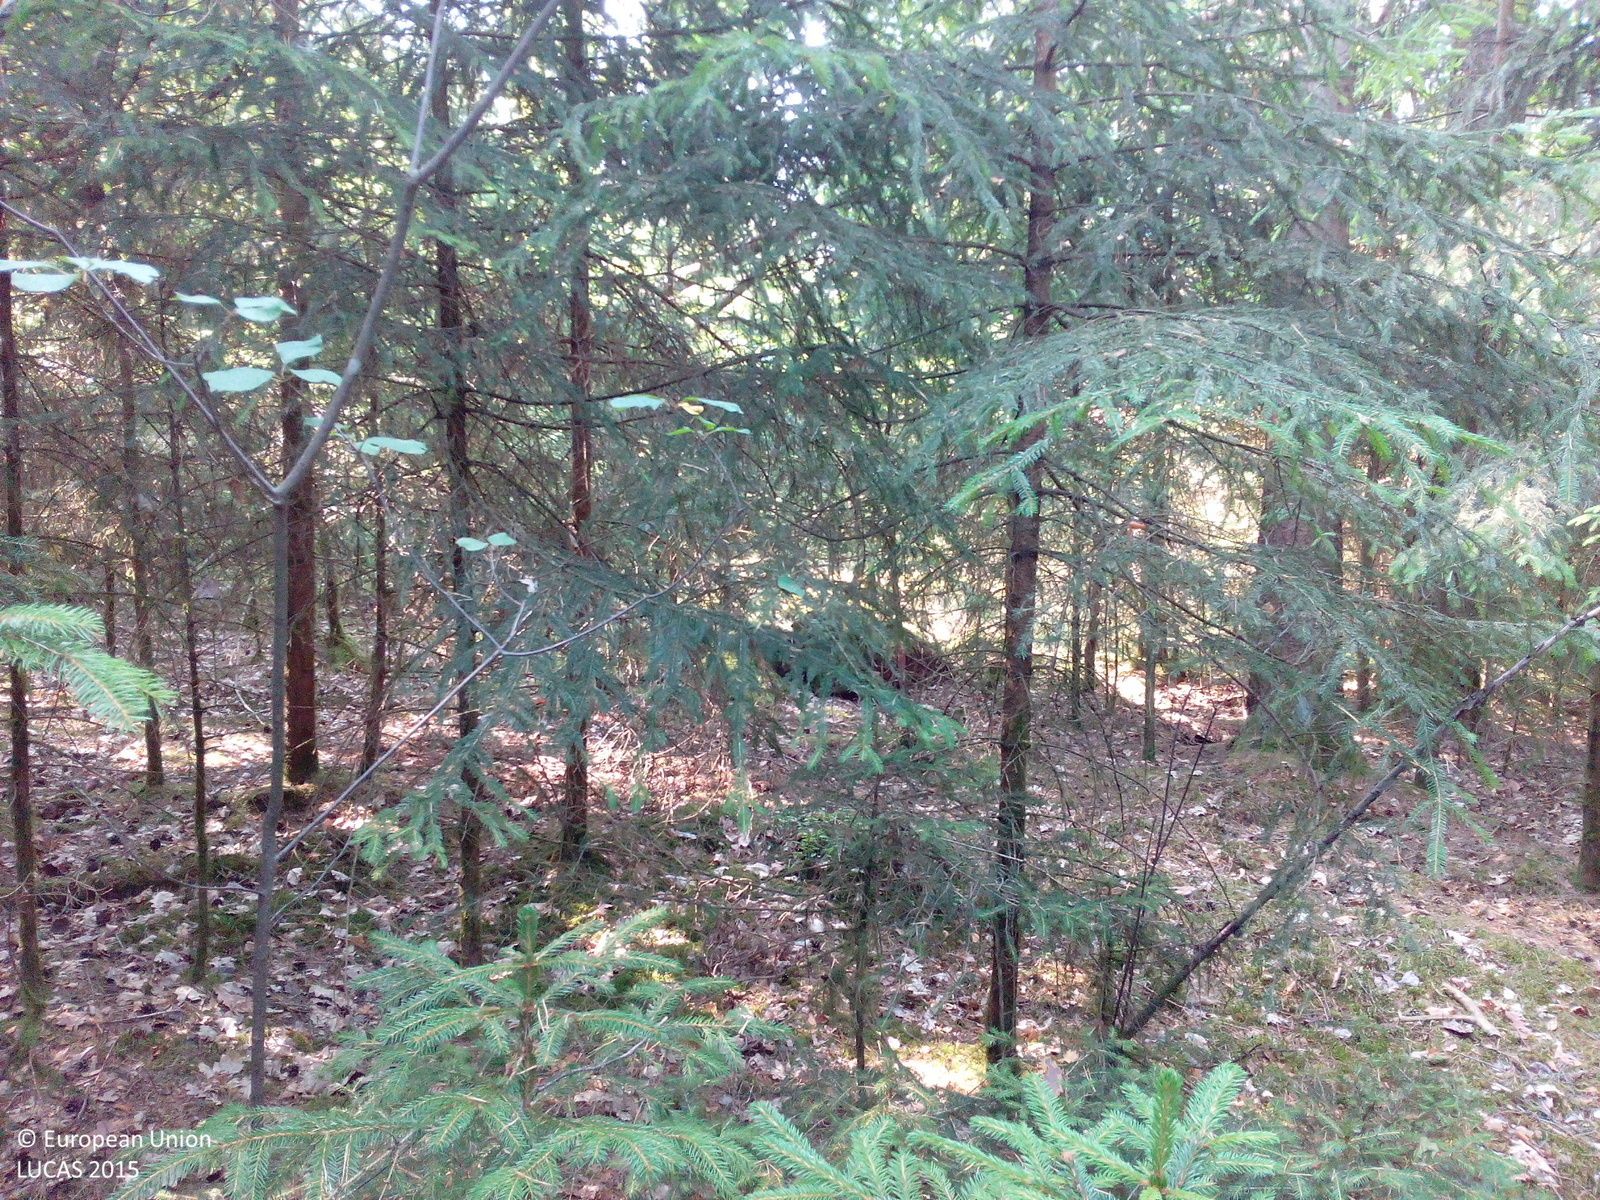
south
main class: Woodland
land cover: Spruce dominated coniferous woodland
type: hemiboreal forest and nemoral coniferous forest and mixed broadleaved-coniferous forest
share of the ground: > 75 %
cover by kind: coniferous forest trees 80 %, lichens and mosses 10 %, broadleaved forest trees 5 %, shrubs 5 %
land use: Forestry
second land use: Amenities, museums, leisure
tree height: > 5 m
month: August
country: DE
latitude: 50.0830
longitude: 11.6067
